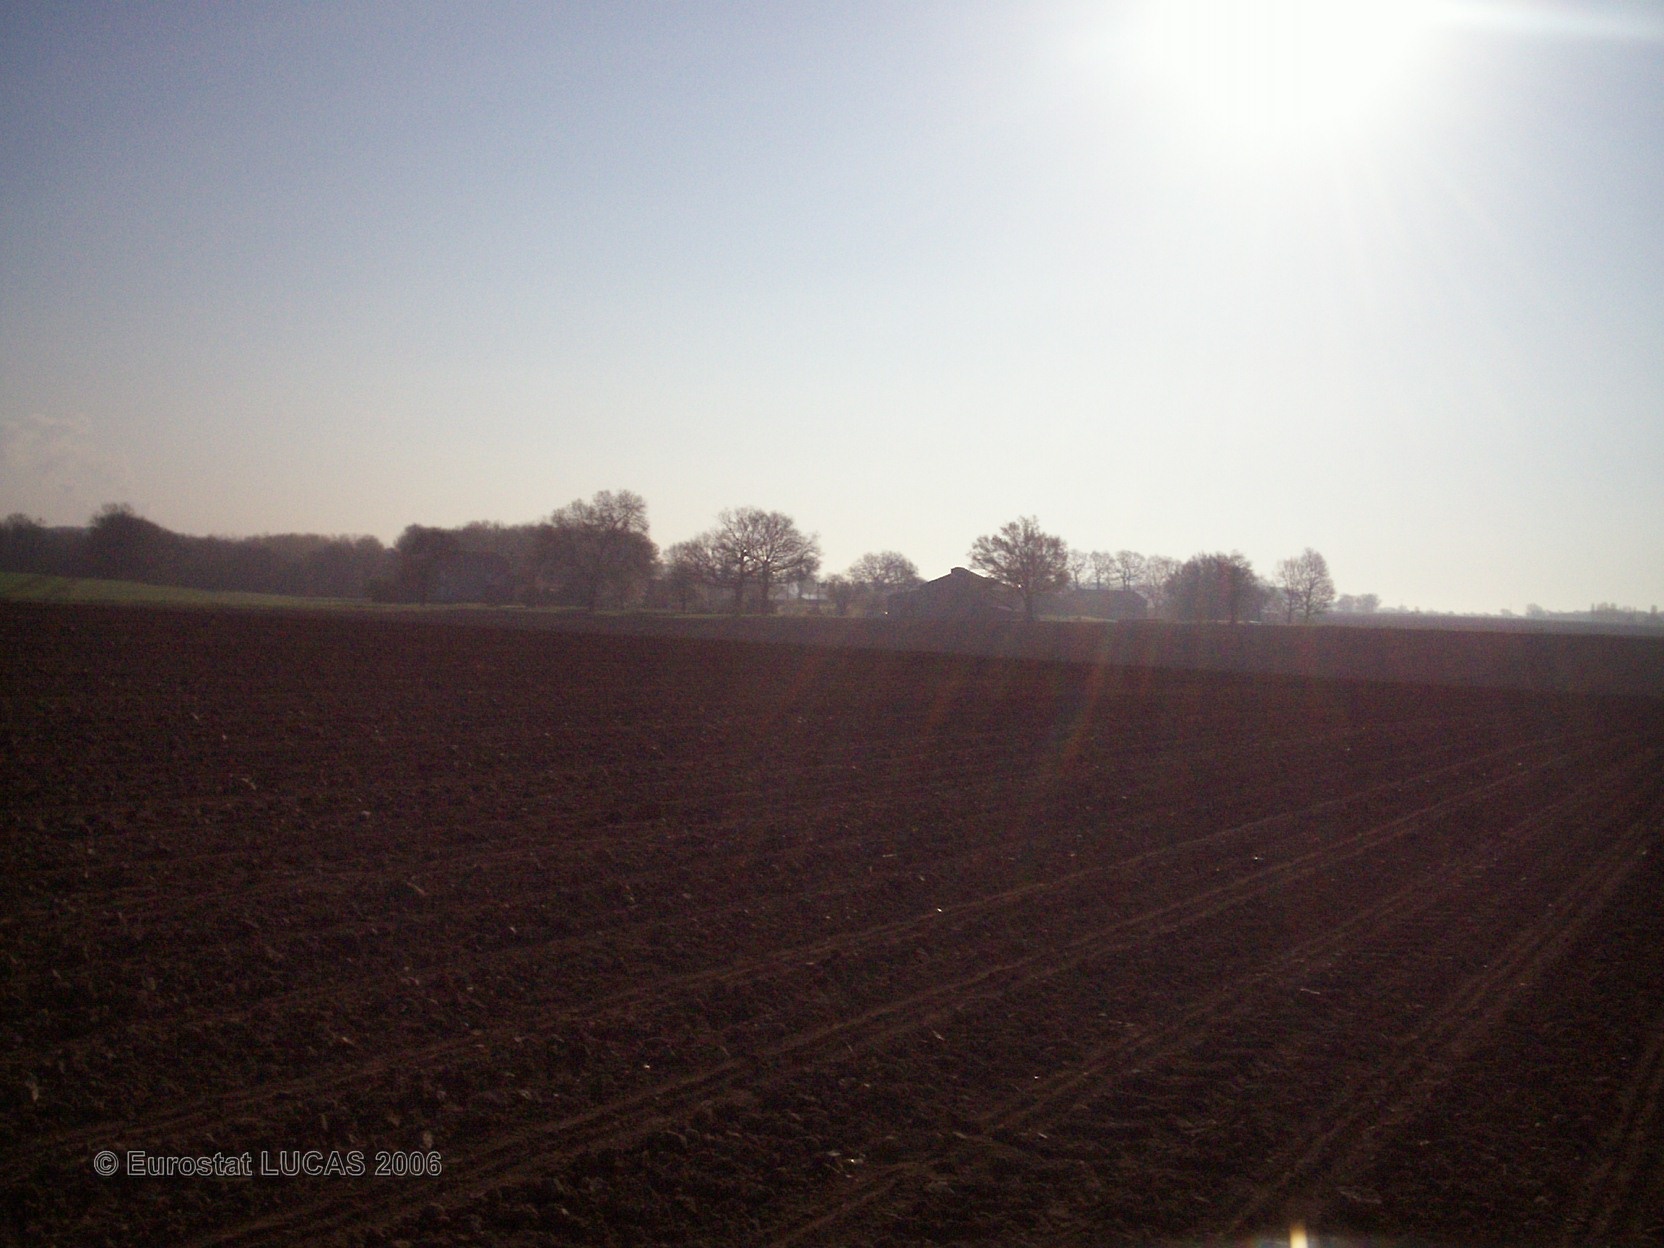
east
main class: Cropland
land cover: Maize
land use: Agriculture (excluding fallow land and kitchen gardens)
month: April
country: FR
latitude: 46.3564
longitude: 0.4305
